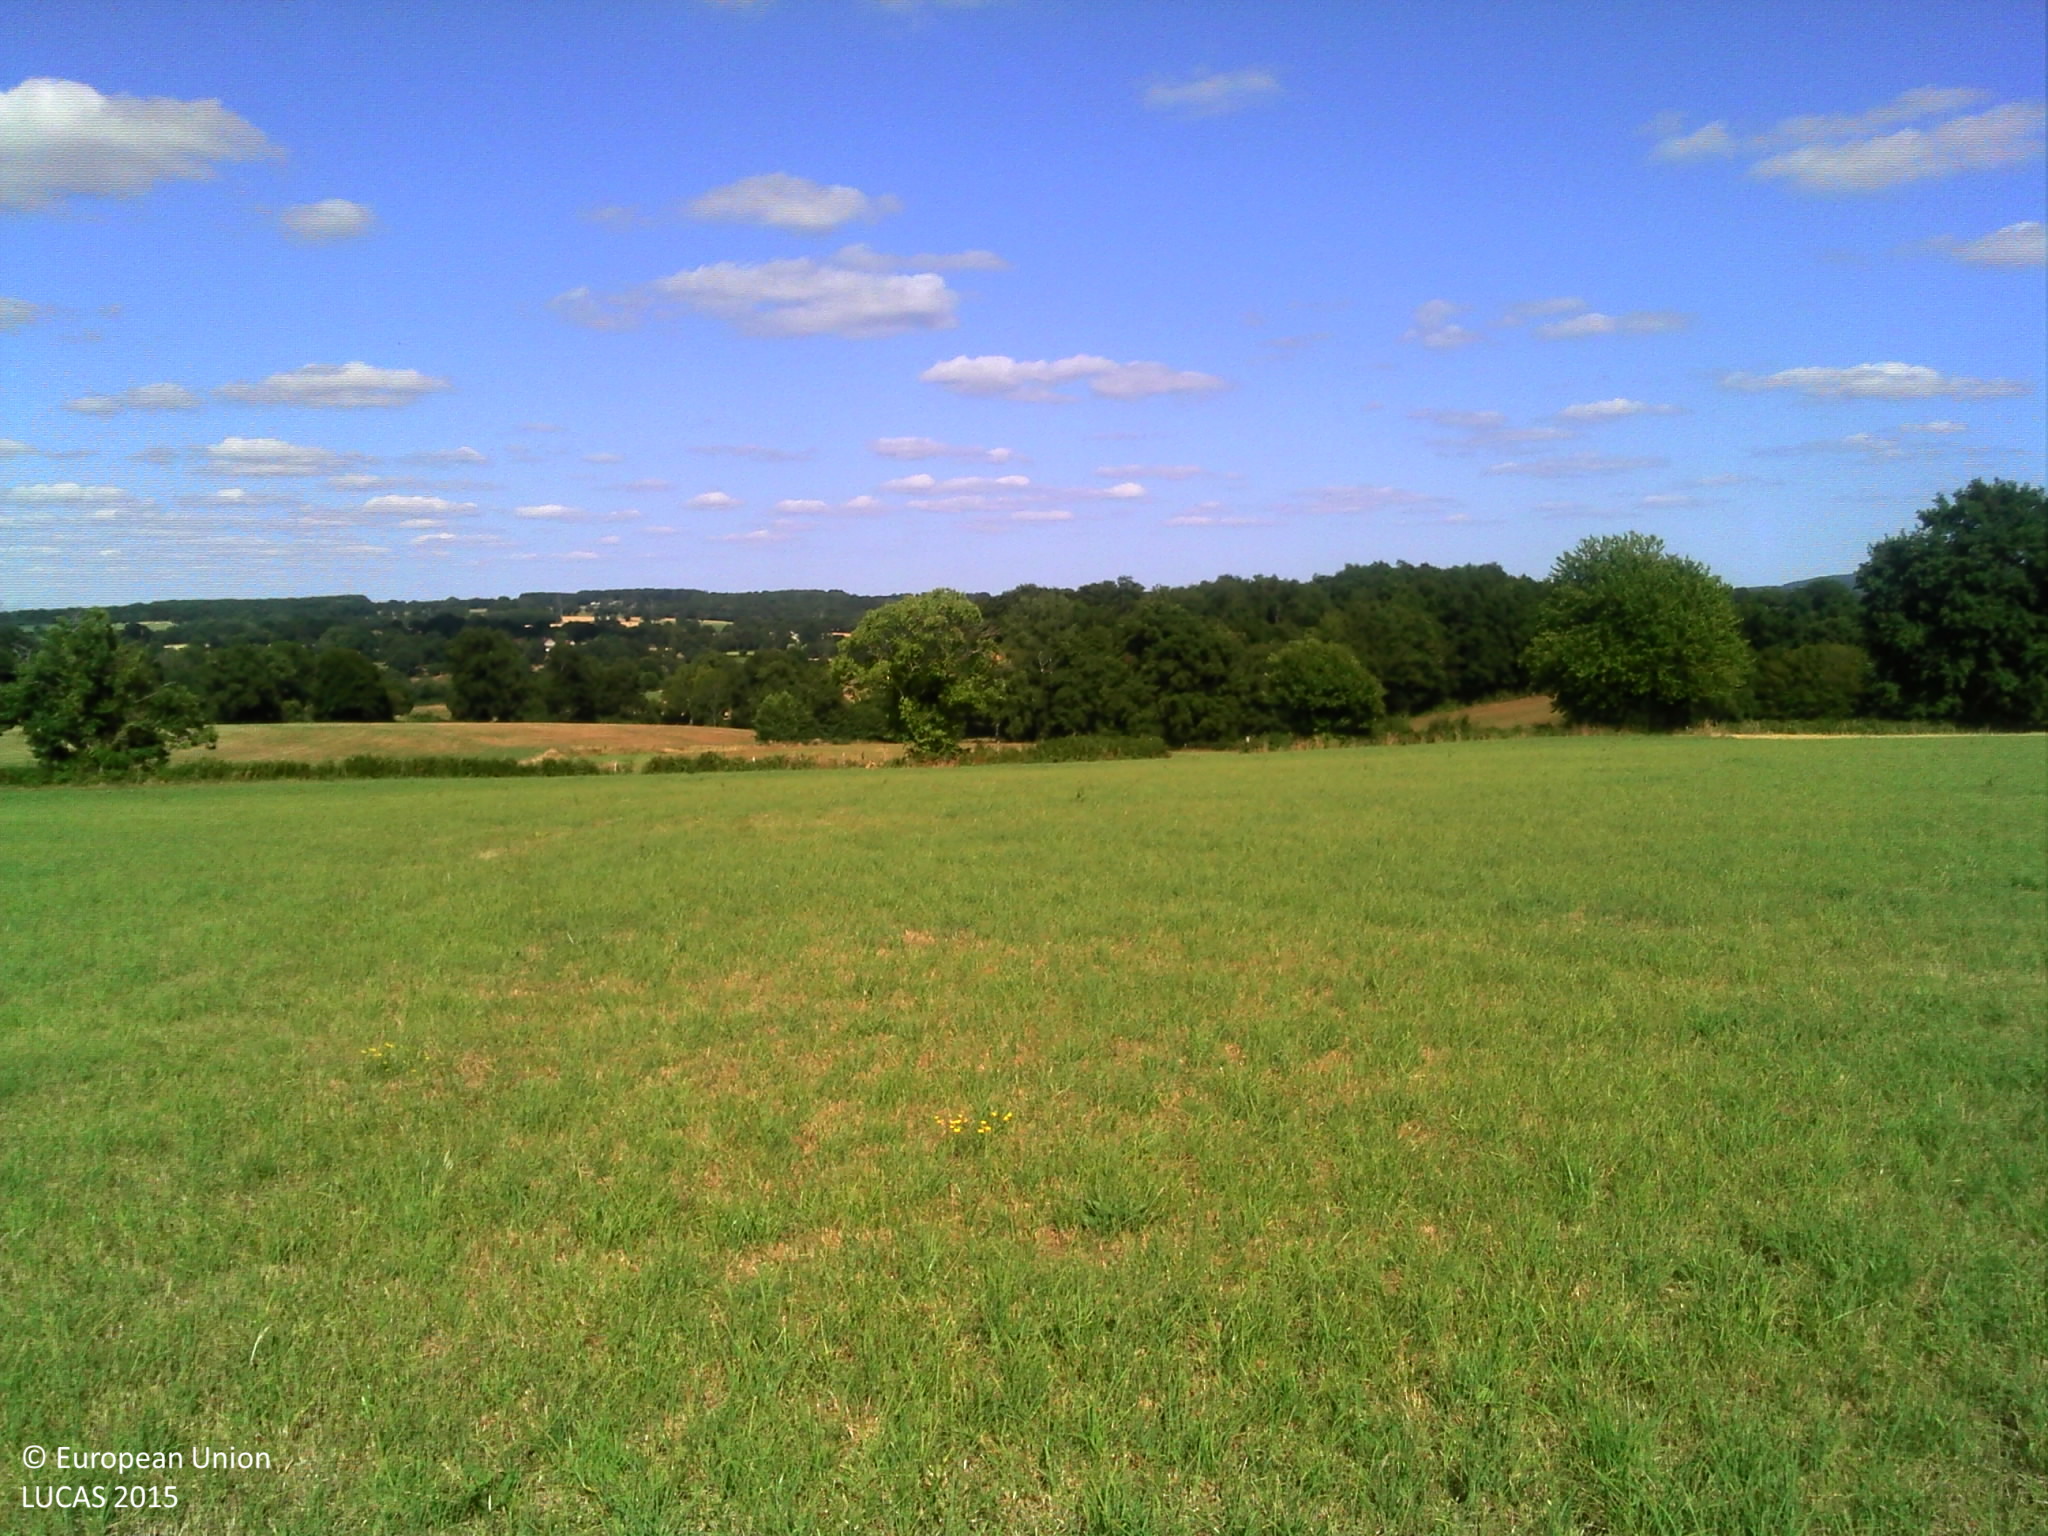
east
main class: Grassland
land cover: Grassland without tree/shrub cover
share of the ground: > 75 %
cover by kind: herbaceous plants 100 %
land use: Agriculture (excluding fallow land and kitchen gardens)
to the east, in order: Grassland without tree/shrub cover; Tracks; Spontaneously vegetated surfaces; Fences; Grassland without tree/shrub cover; Fences; Grassland without tree/shrub cover
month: July
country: FR
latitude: 46.3113
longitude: 1.6155
